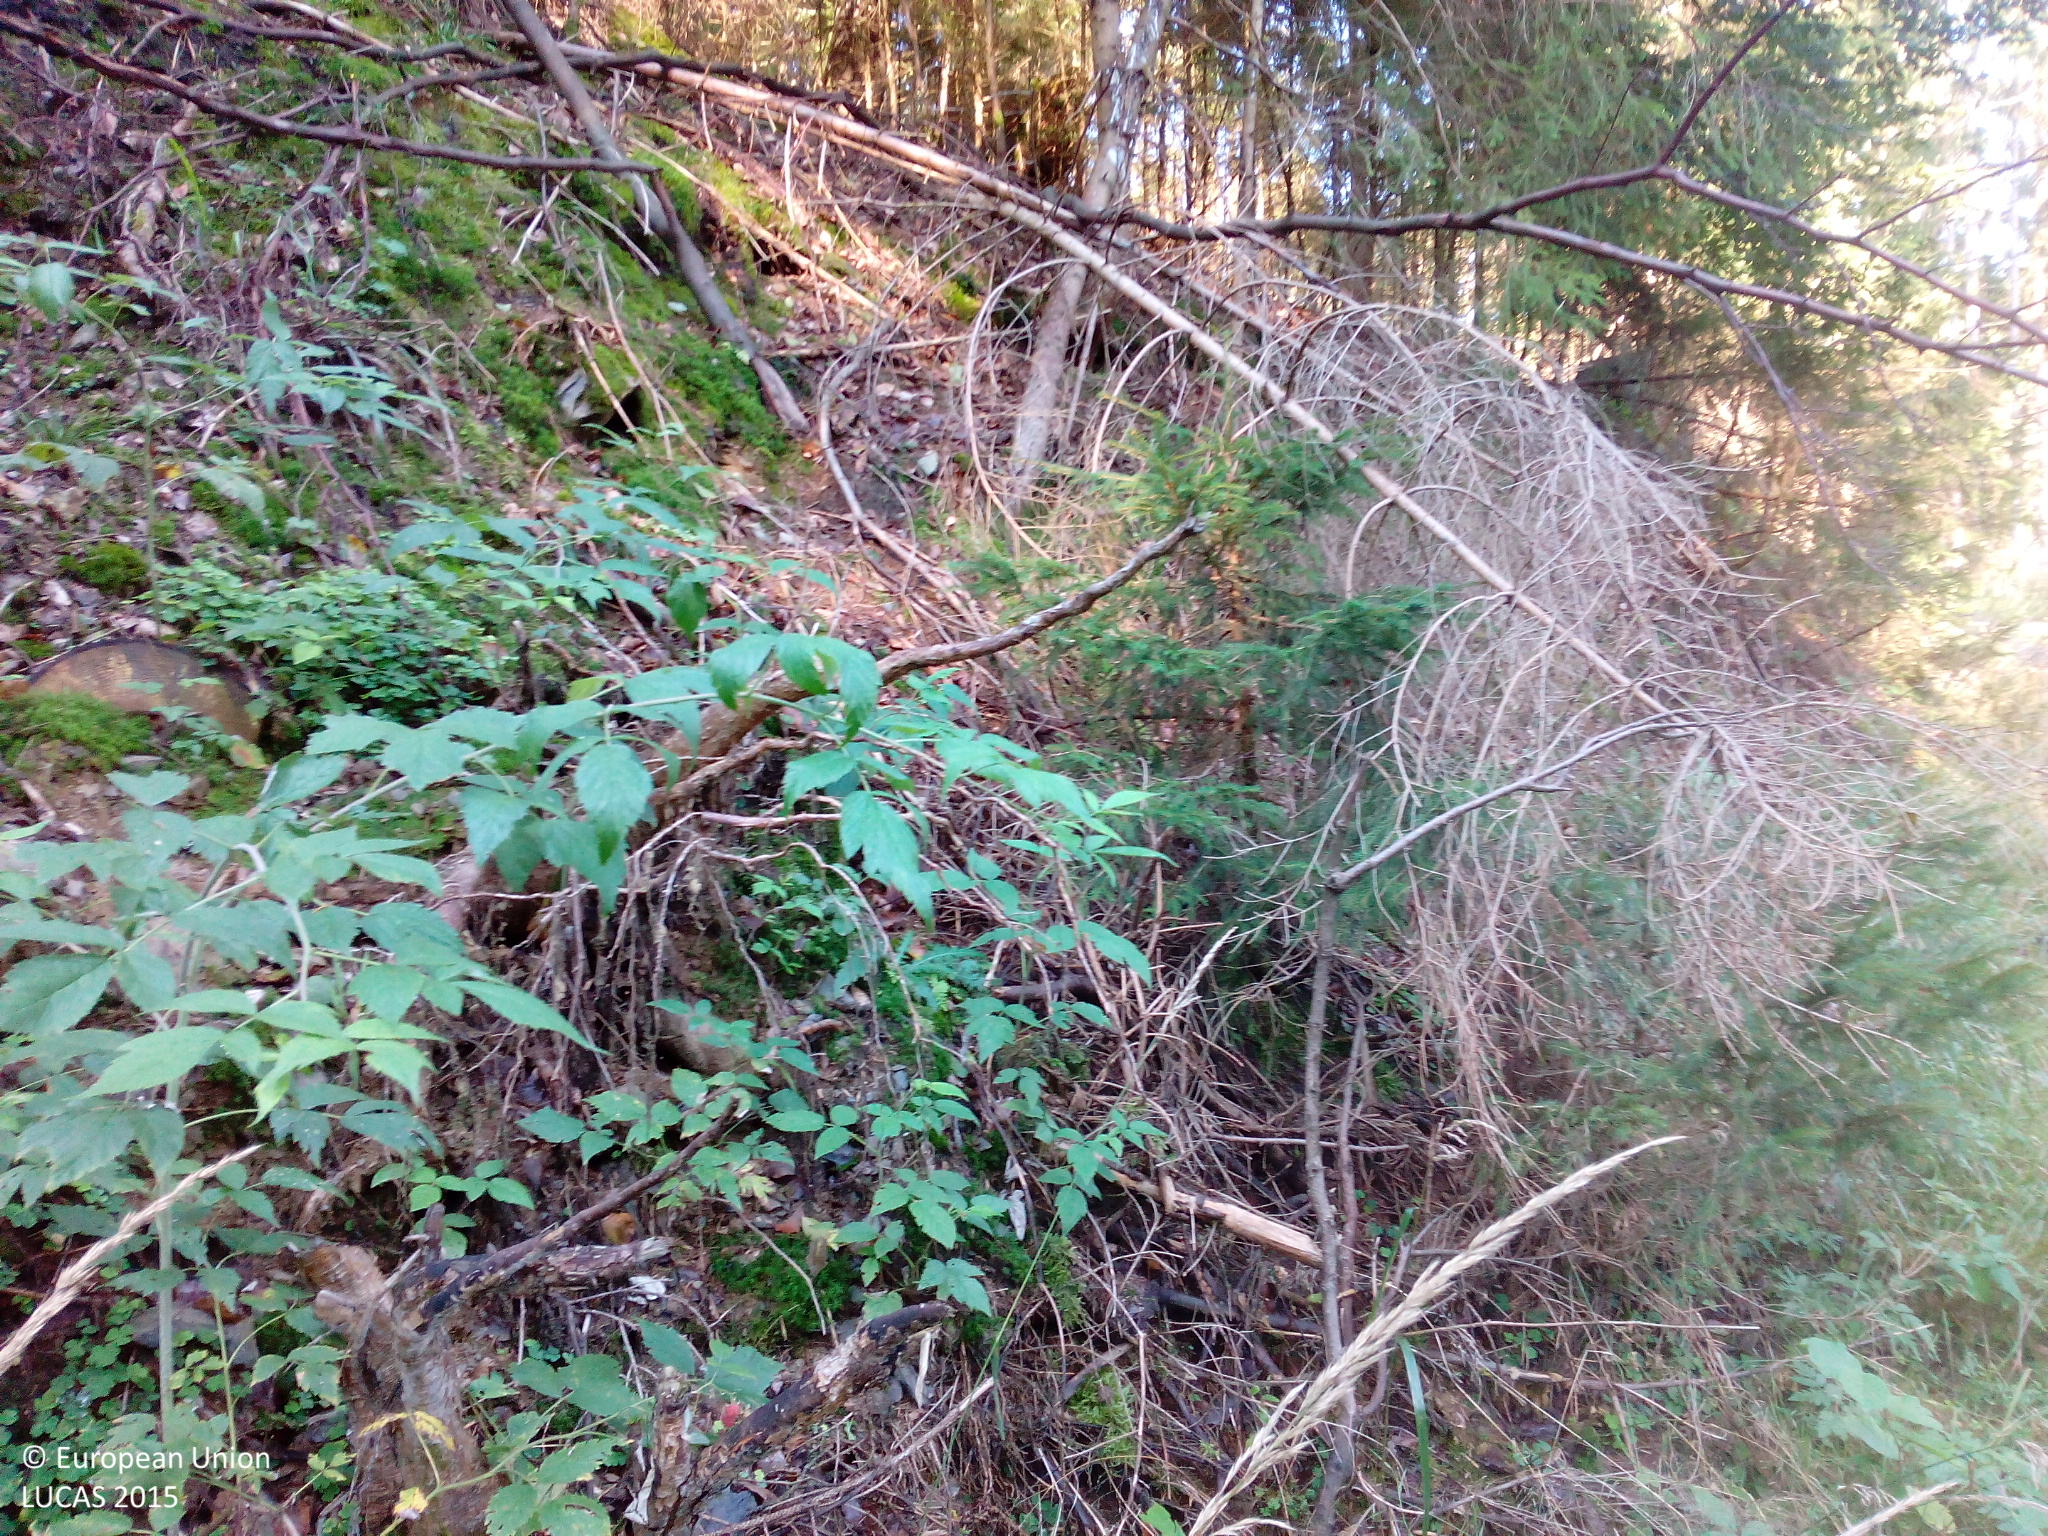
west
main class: Woodland
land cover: Spruce dominated coniferous woodland
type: hemiboreal forest and nemoral coniferous forest and mixed broadleaved-coniferous forest
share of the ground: > 75 %
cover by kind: coniferous forest trees 80 %, broadleaved forest trees 10 %
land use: Forestry
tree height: > 5 m
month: August
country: DE
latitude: 50.3178
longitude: 11.5304
